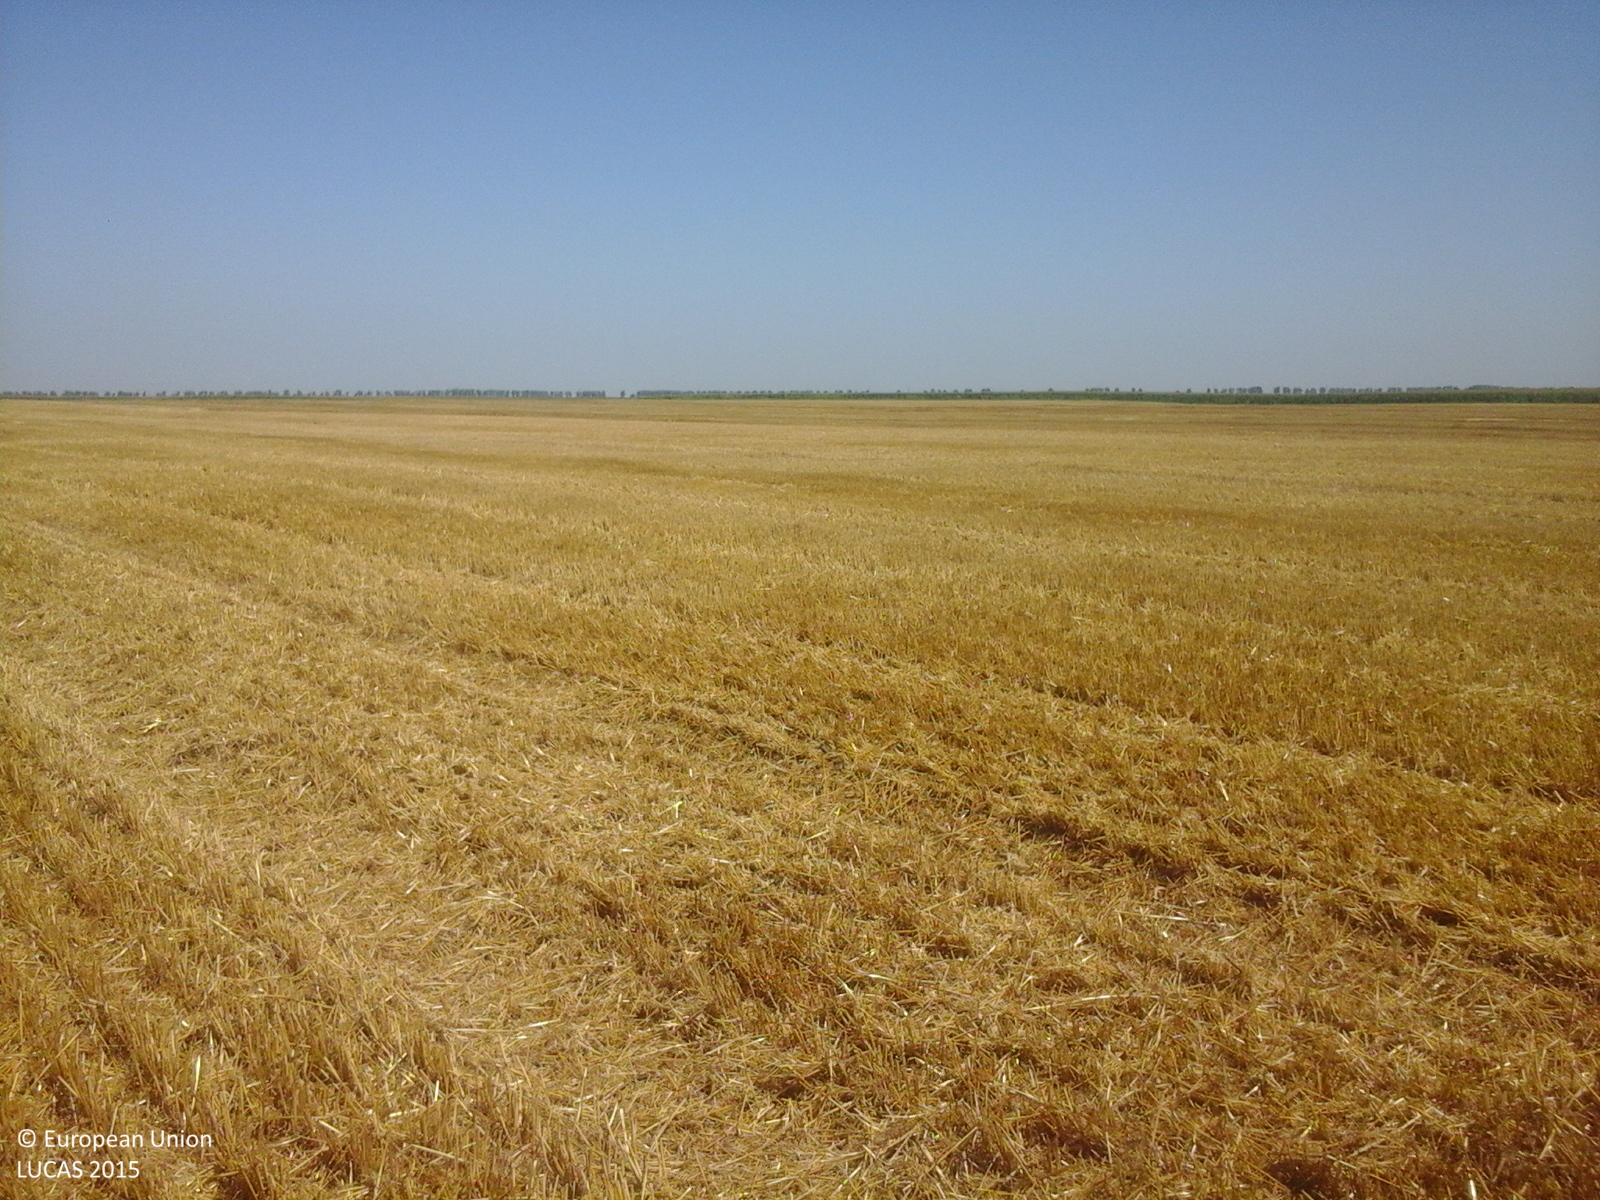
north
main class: Cropland
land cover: Durum wheat
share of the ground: 50 - 75 %
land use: Agriculture (excluding fallow land and kitchen gardens)
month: July
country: RO
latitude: 44.2116
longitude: 26.6236
